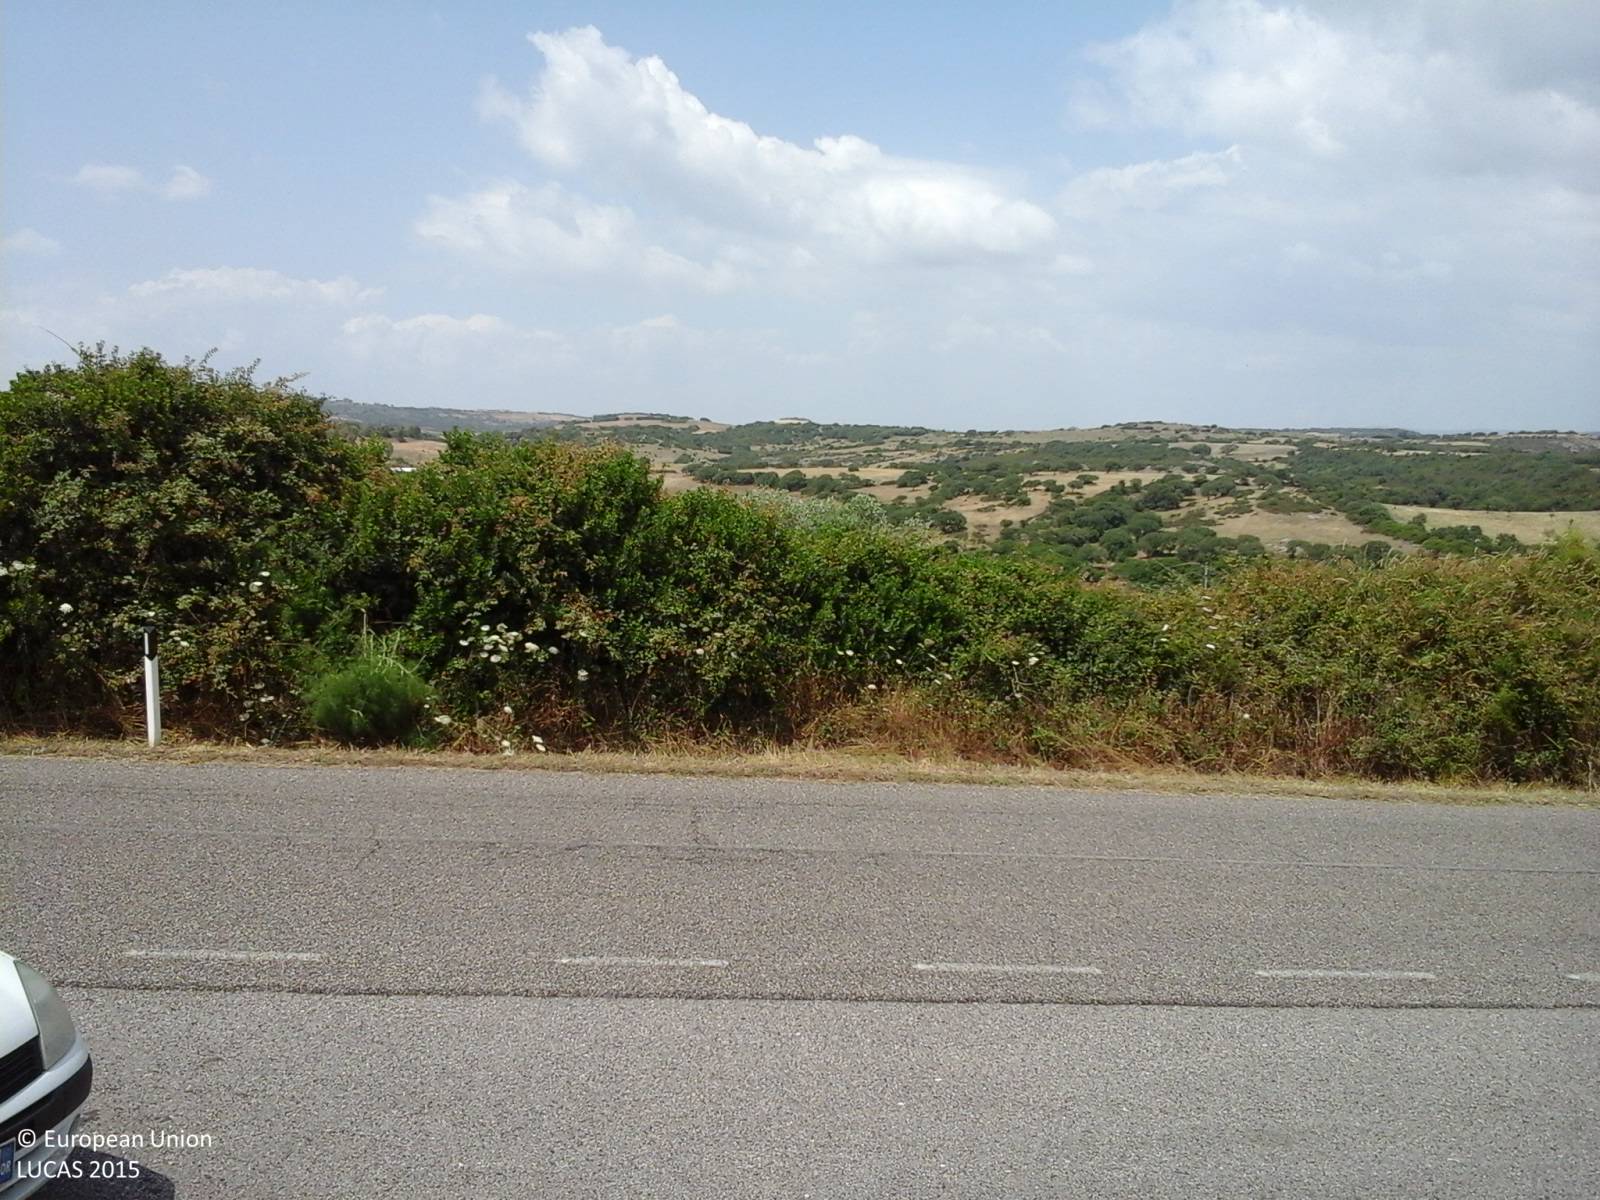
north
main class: Grassland
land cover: Grassland without tree/shrub cover
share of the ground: > 75 %
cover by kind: herbaceous plants 100 %
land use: Agriculture (excluding fallow land and kitchen gardens)
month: June
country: IT
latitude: 39.8627
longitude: 8.8956
